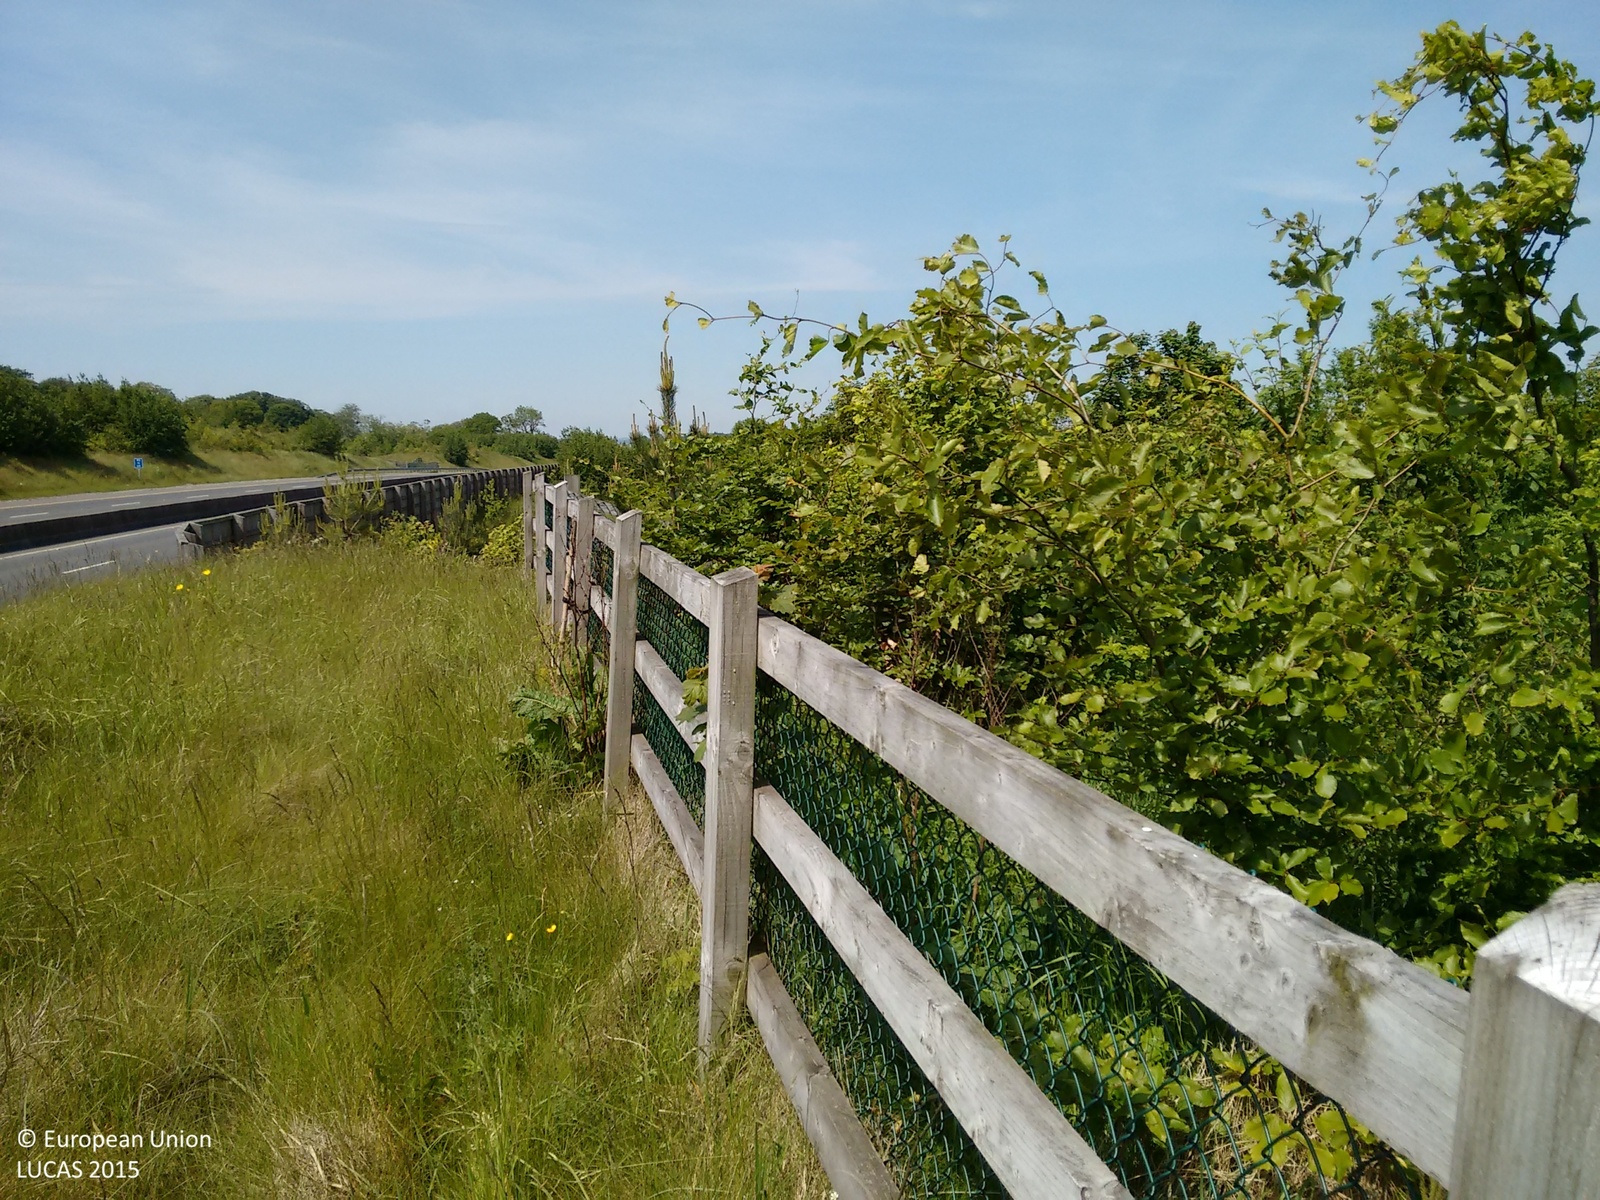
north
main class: Woodland
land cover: Broadleaved woodland
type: acidophilous oak and oak-birch forest
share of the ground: > 75 %
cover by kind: broadleaved forest trees 90 %, coniferous forest trees 10 %
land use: Road transport
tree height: < 5 m
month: June
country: IE
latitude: 53.5716
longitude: -6.5736
